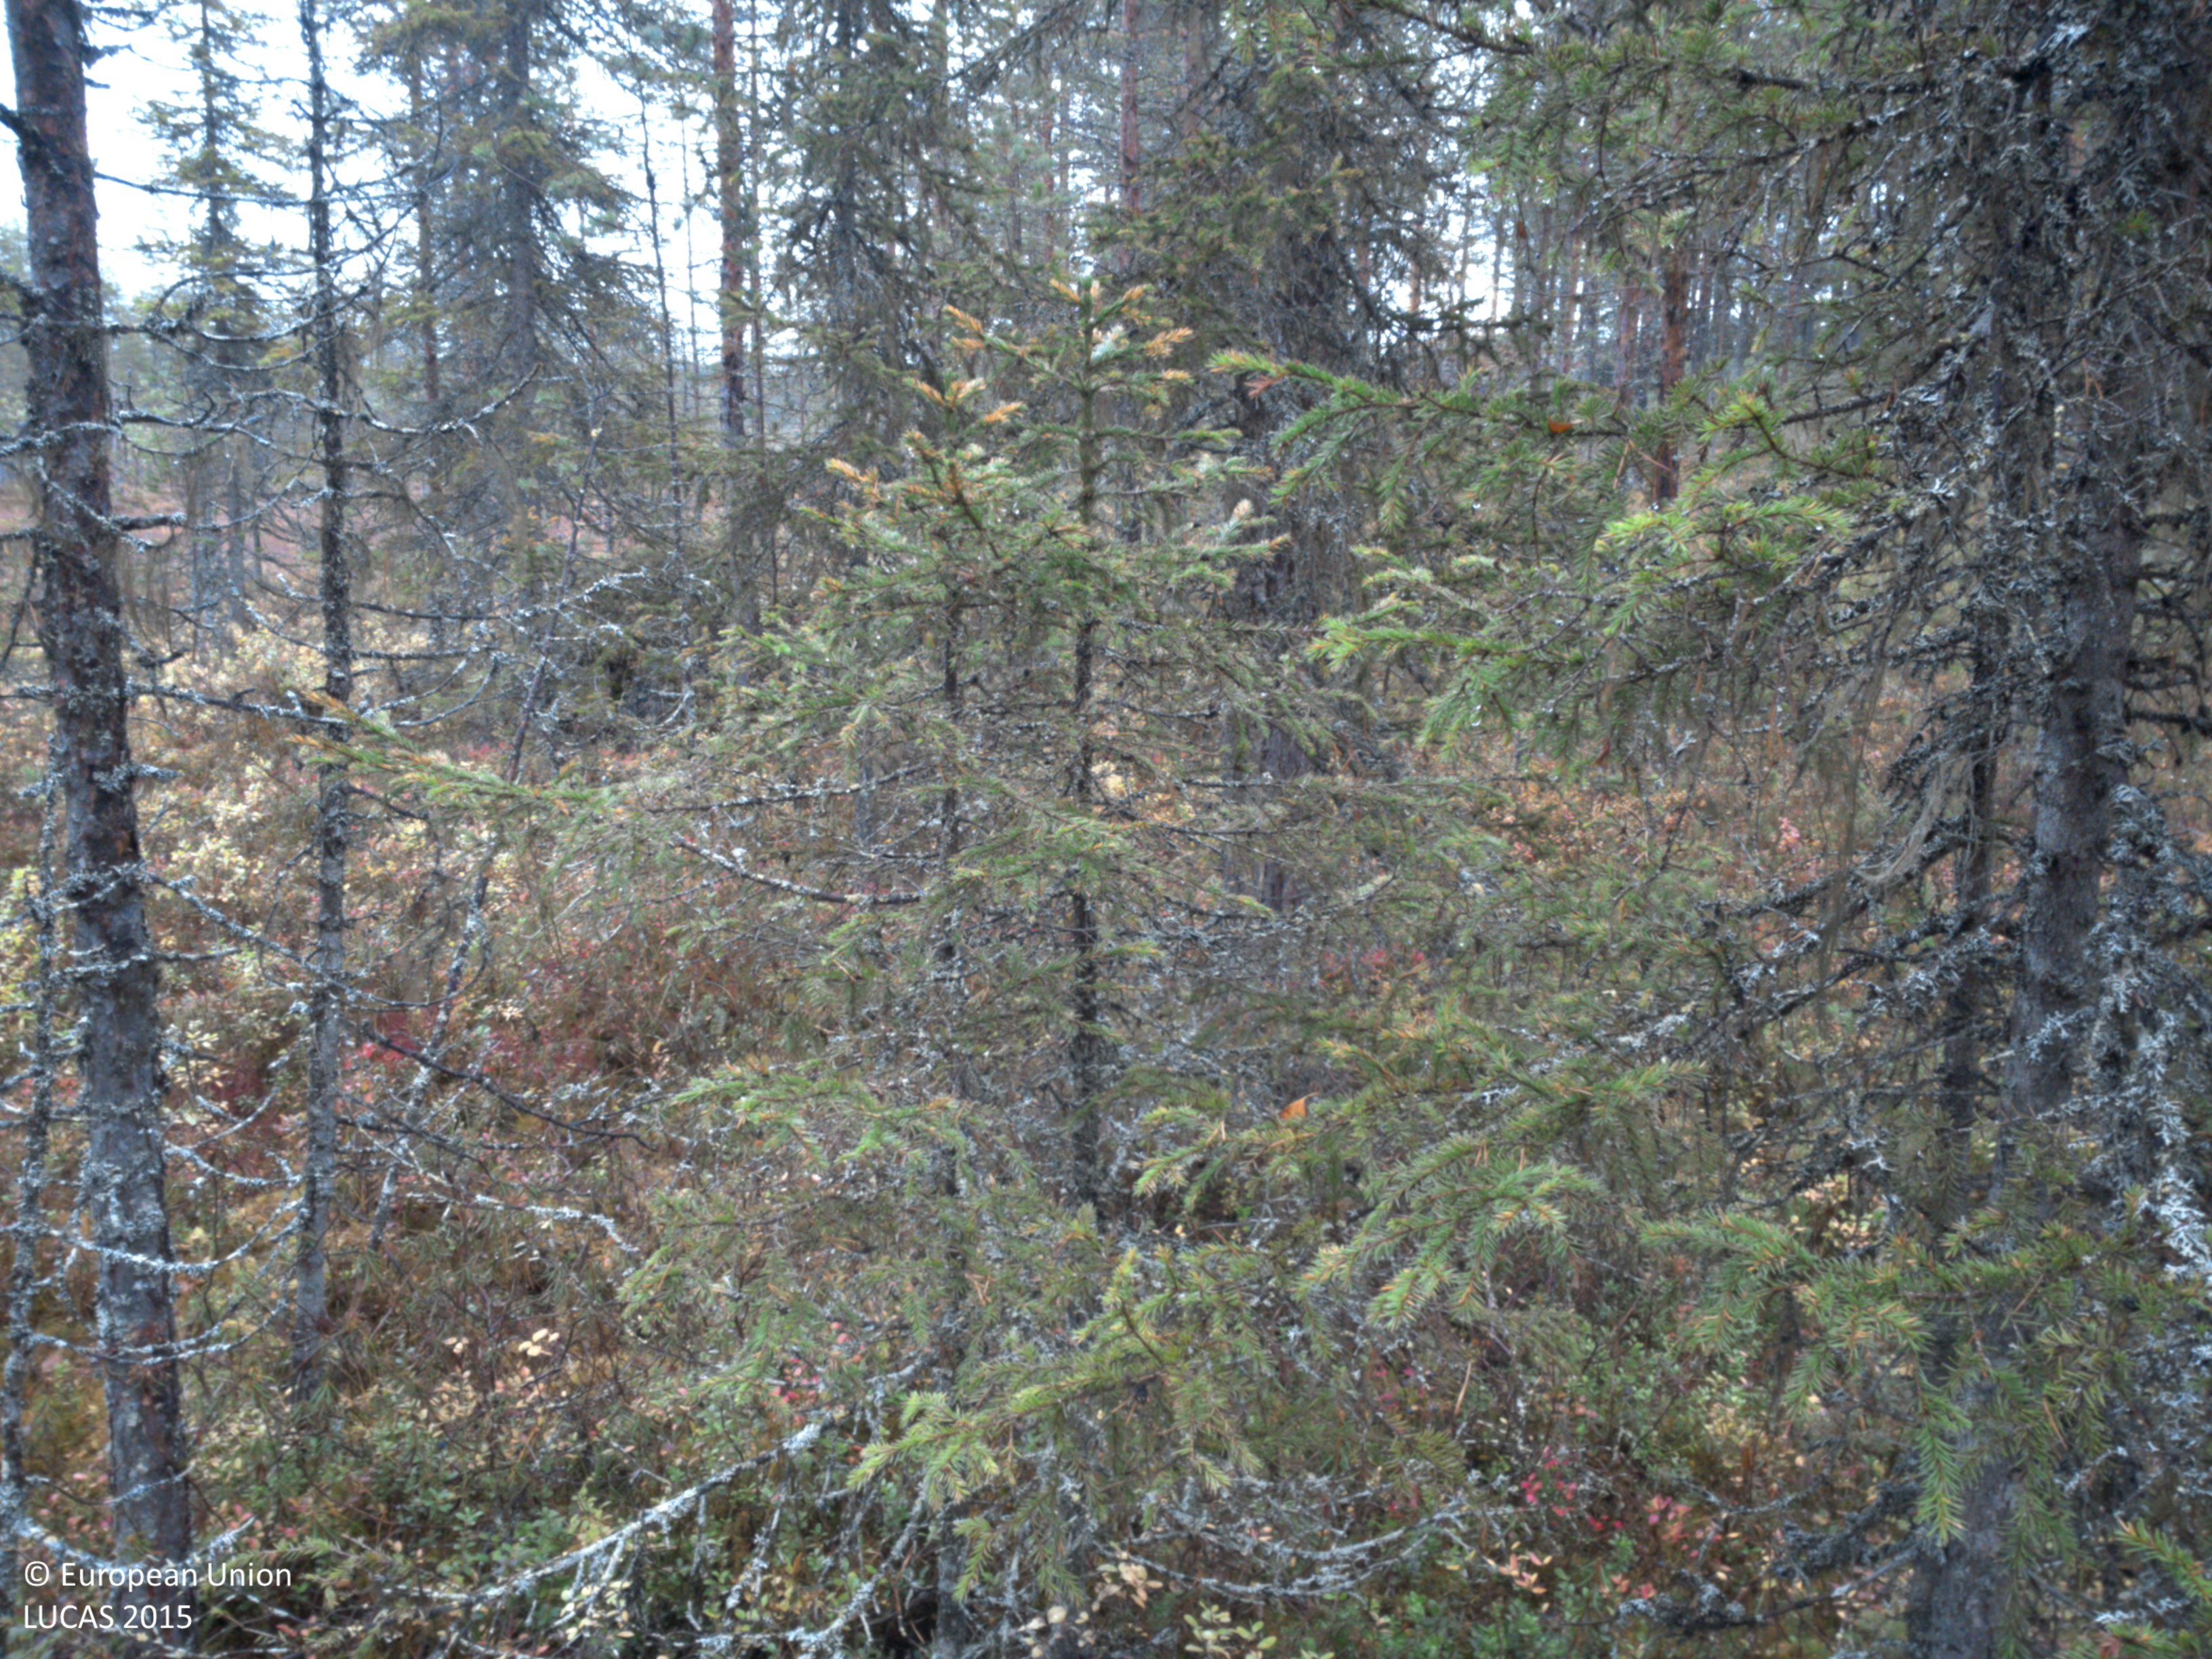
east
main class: Woodland
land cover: Other coniferous woodland
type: boreal forest
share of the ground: 50 - 75 %
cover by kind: coniferous forest trees 60 %, shrubs 25 %, broadleaved forest trees 10 %, lichens and mosses 5 %
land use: Forestry
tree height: > 5 m
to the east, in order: Other coniferous woodland; Pine dominated coniferous woodland; Peatbogs; Inland fresh water bodies; Peatbogs; Pine dominated coniferous woodland
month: September
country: SE
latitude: 64.9811
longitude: 18.9720
